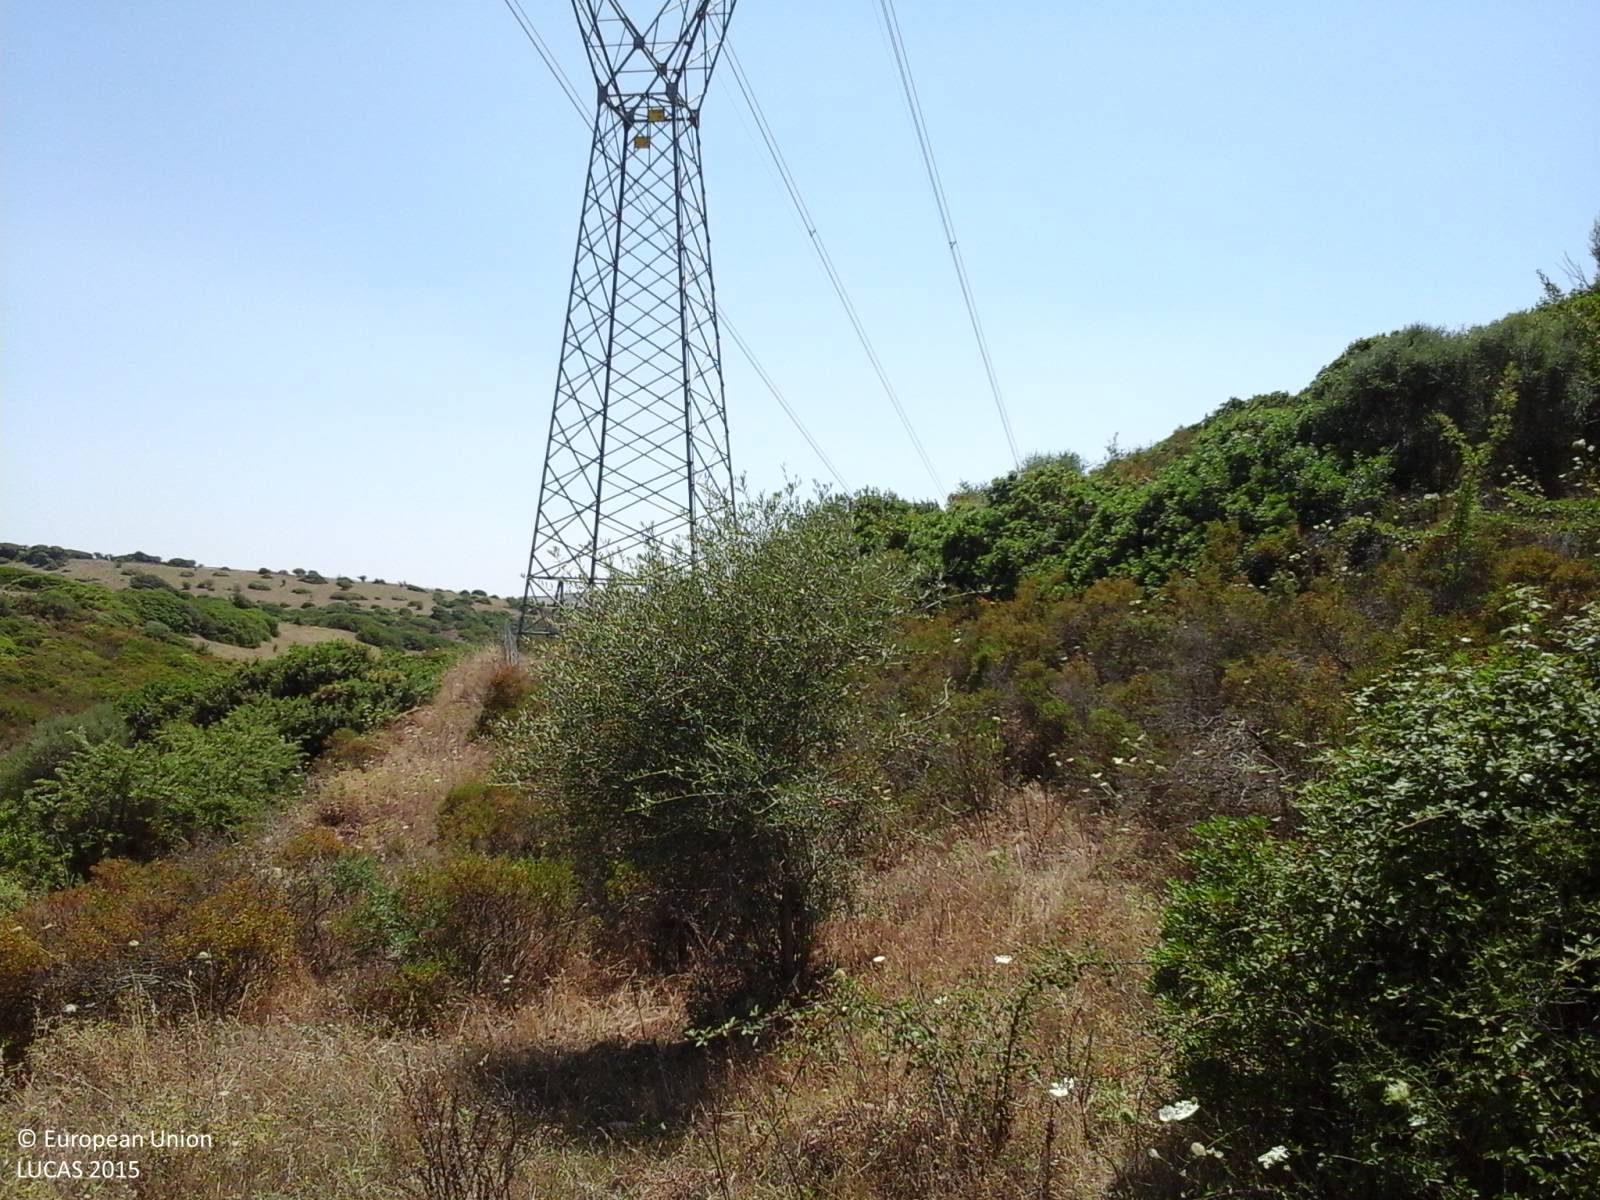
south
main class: Grassland
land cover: Grassland with sparse tree/shrub cover
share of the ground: > 75 %
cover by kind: herbaceous plants 90 %, broadleaved forest trees 5 %, shrubs 5 %
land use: Agriculture (excluding fallow land and kitchen gardens)
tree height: < 5 m
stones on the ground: > 50 %
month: June
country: IT
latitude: 39.8803
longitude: 8.8488
